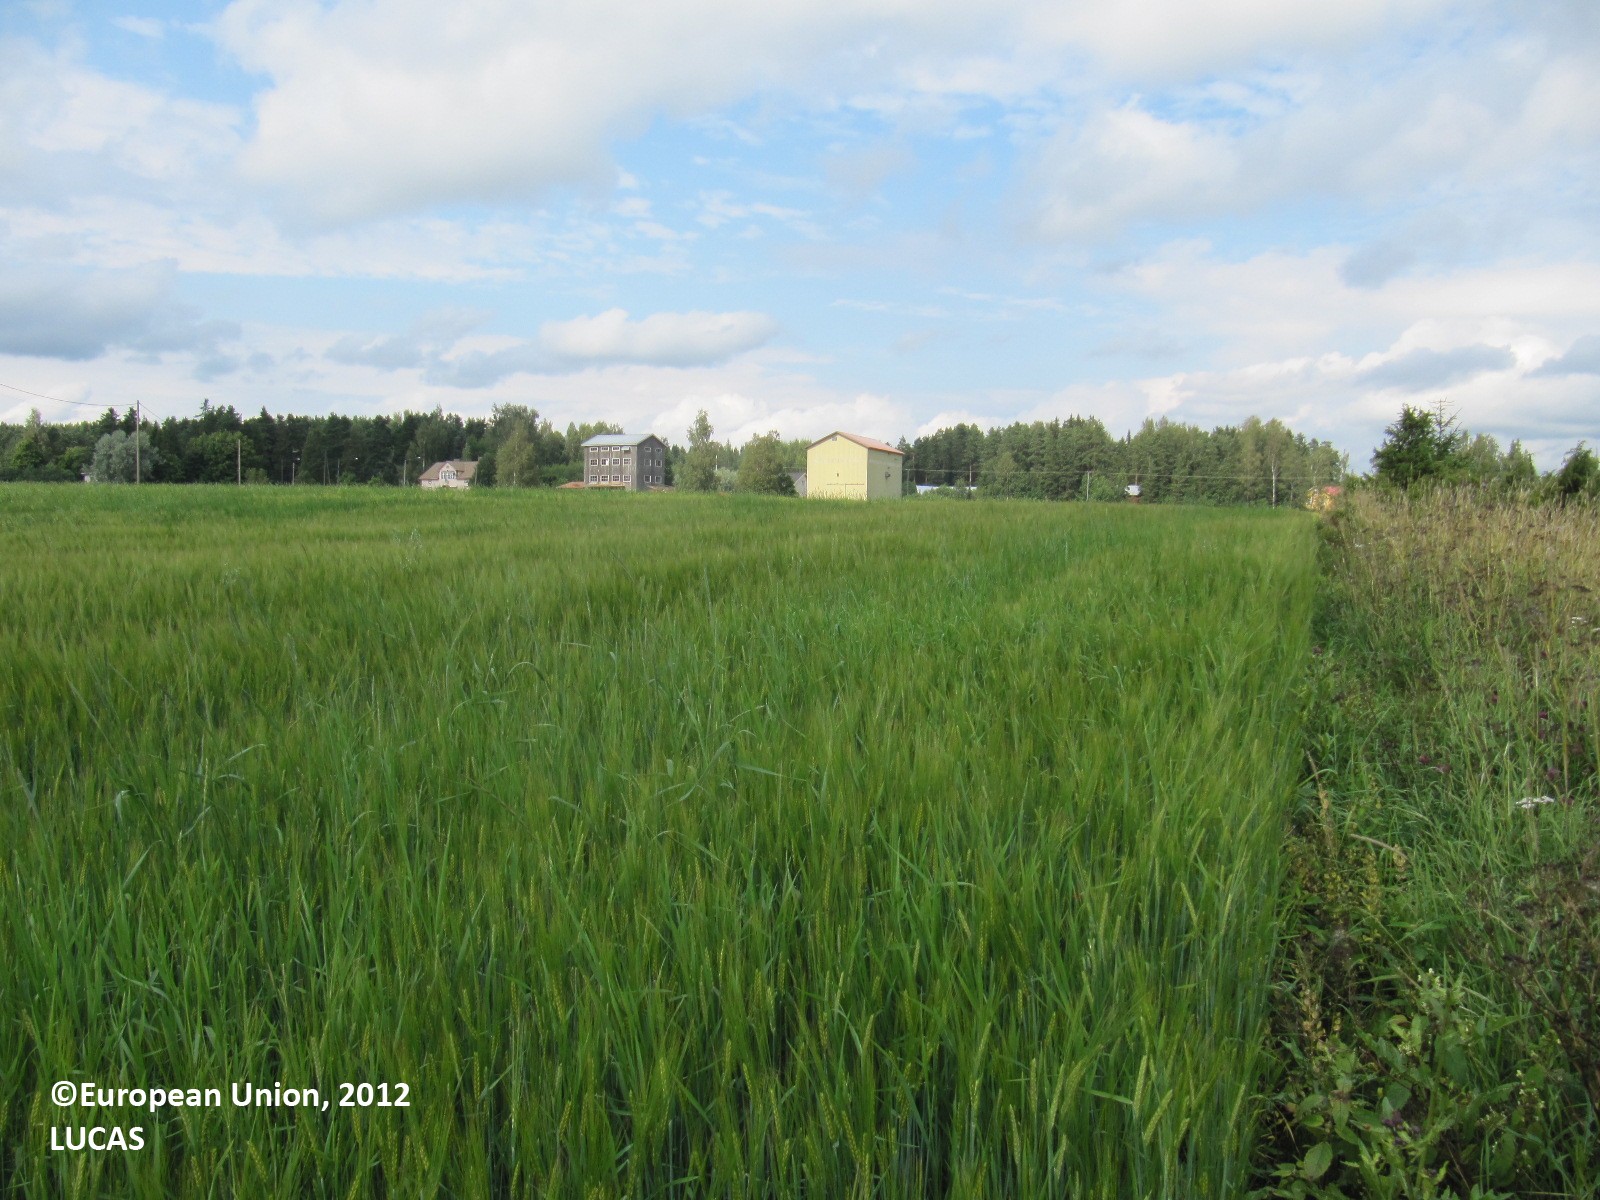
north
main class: Cropland
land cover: Barley
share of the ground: > 75 %
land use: Agriculture (excluding fallow land and kitchen gardens)
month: July
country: FI
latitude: 60.6623
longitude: 23.3110
